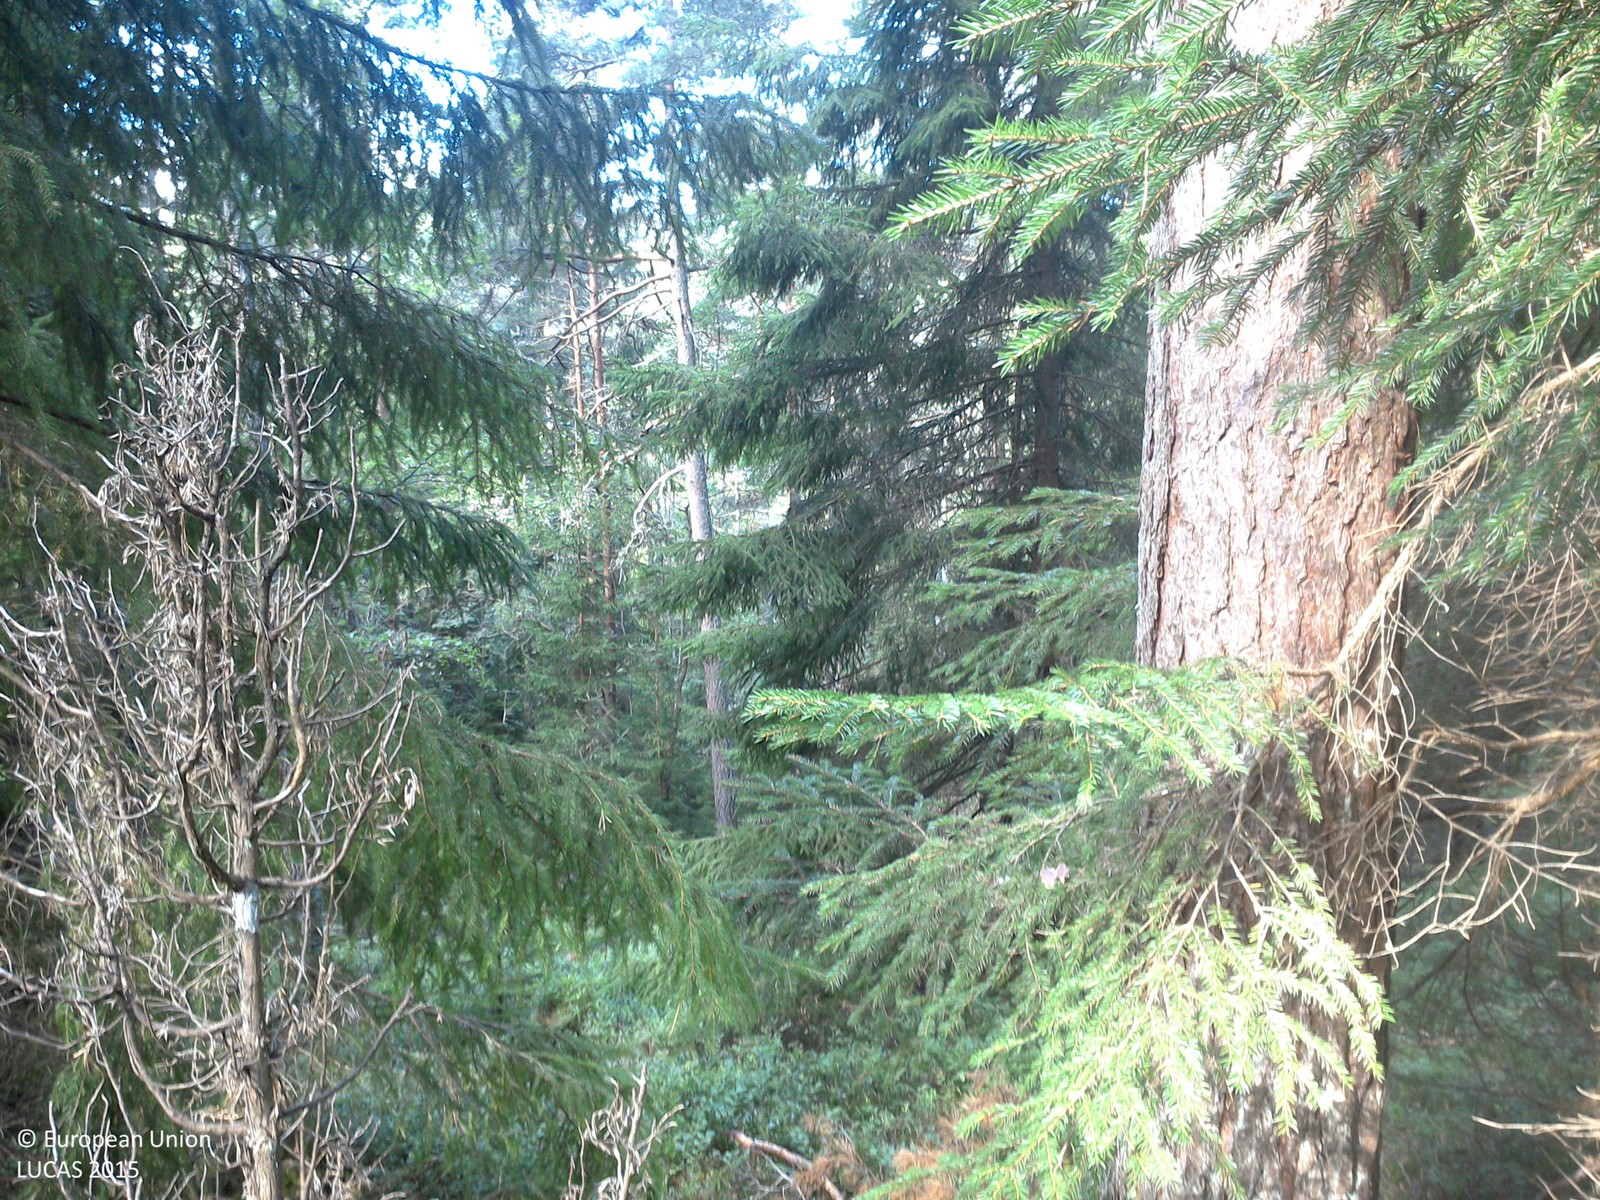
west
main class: Woodland
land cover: Spruce dominated coniferous woodland
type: boreal forest
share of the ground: 25 - 50 %
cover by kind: coniferous forest trees 50 %, herbaceous plants 30 %, lichens and mosses 20 %
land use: Forestry
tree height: > 5 m
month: August
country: SE
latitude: 57.9010
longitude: 15.2428
